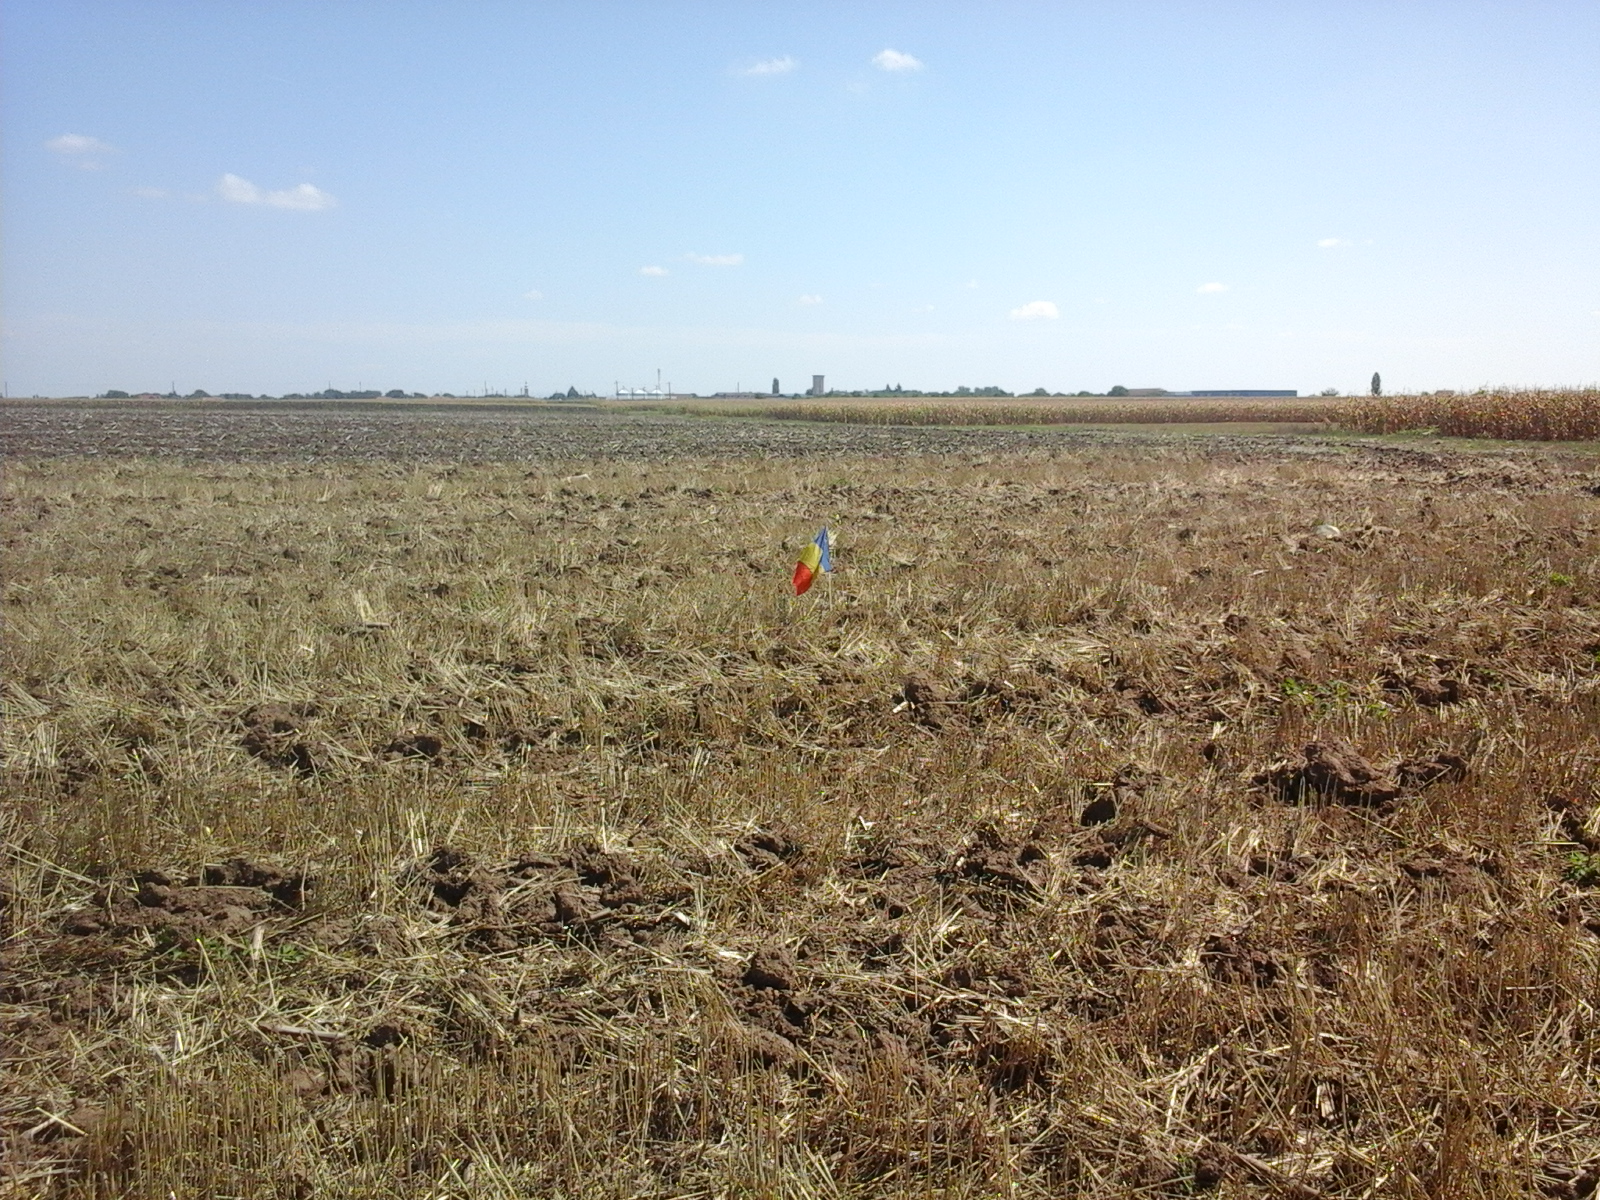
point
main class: Cropland
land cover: Common wheat
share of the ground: 50 - 75 %
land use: Agriculture (excluding fallow land and kitchen gardens)
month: August
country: RO
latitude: 46.1148
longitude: 21.1202
